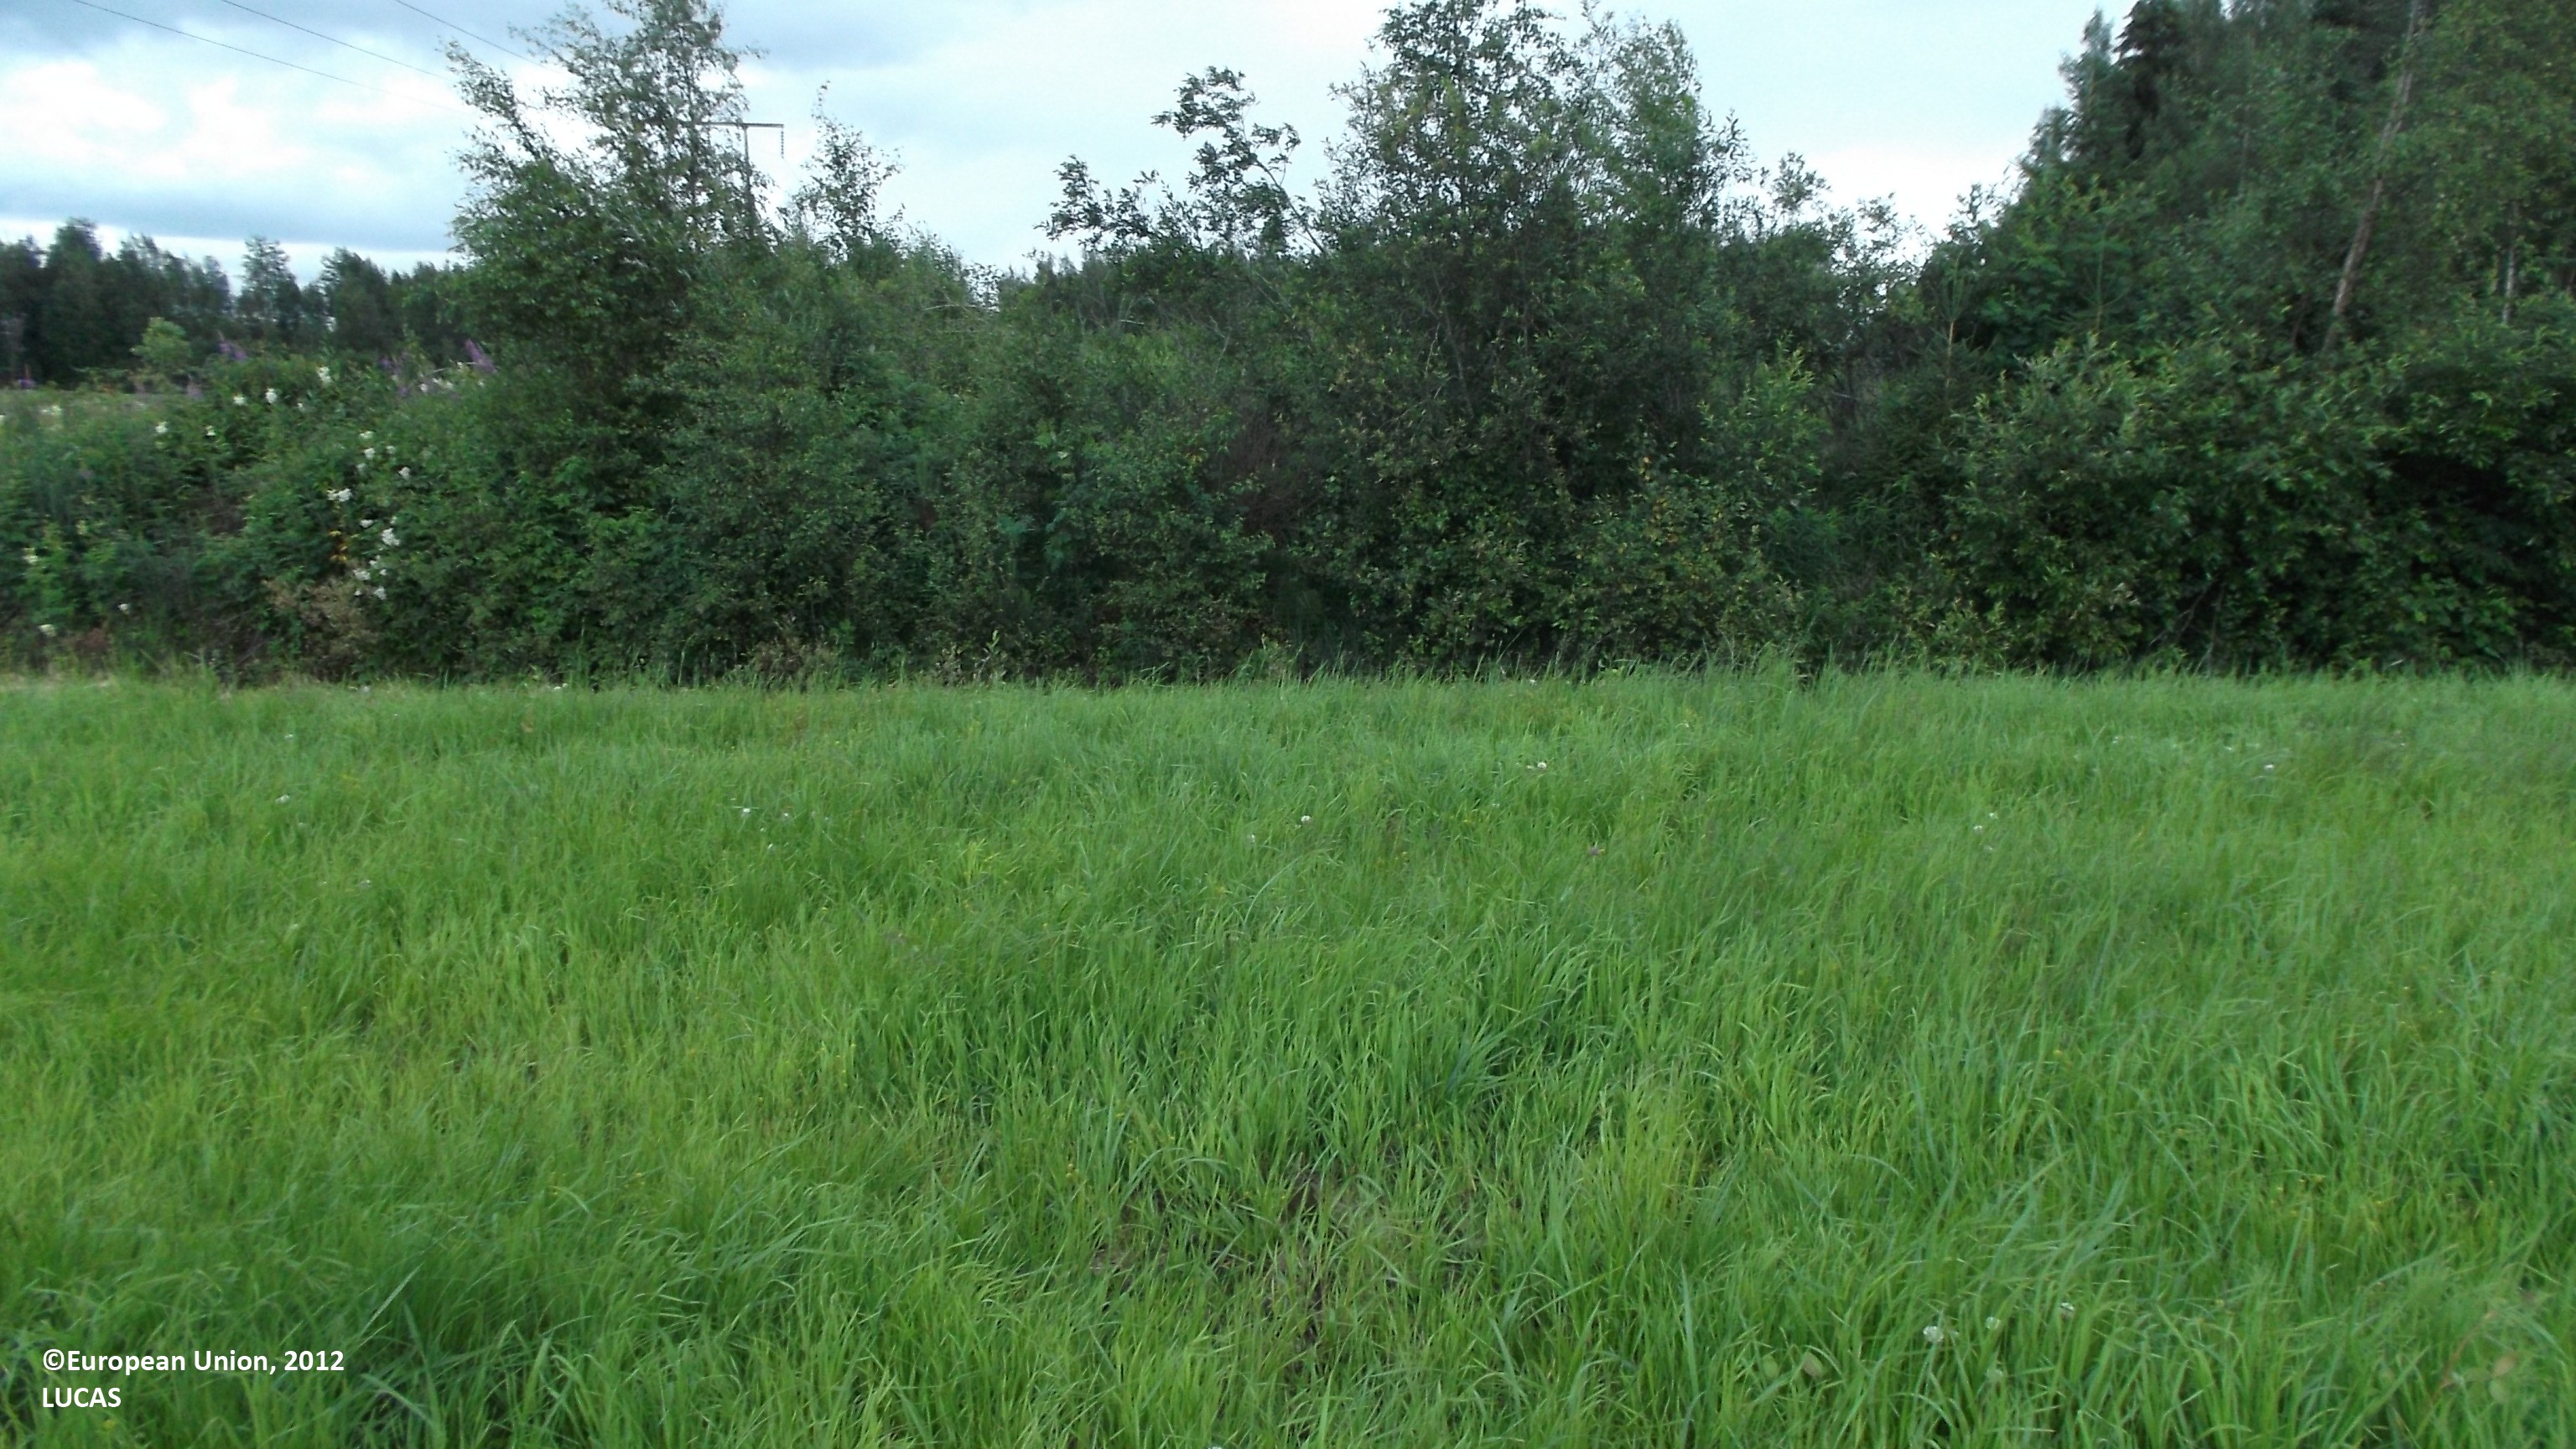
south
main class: Cropland
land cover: Temporary grasslands
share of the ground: > 75 %
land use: Agriculture (excluding fallow land and kitchen gardens)
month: July
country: FI
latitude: 63.6849
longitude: 23.3412
